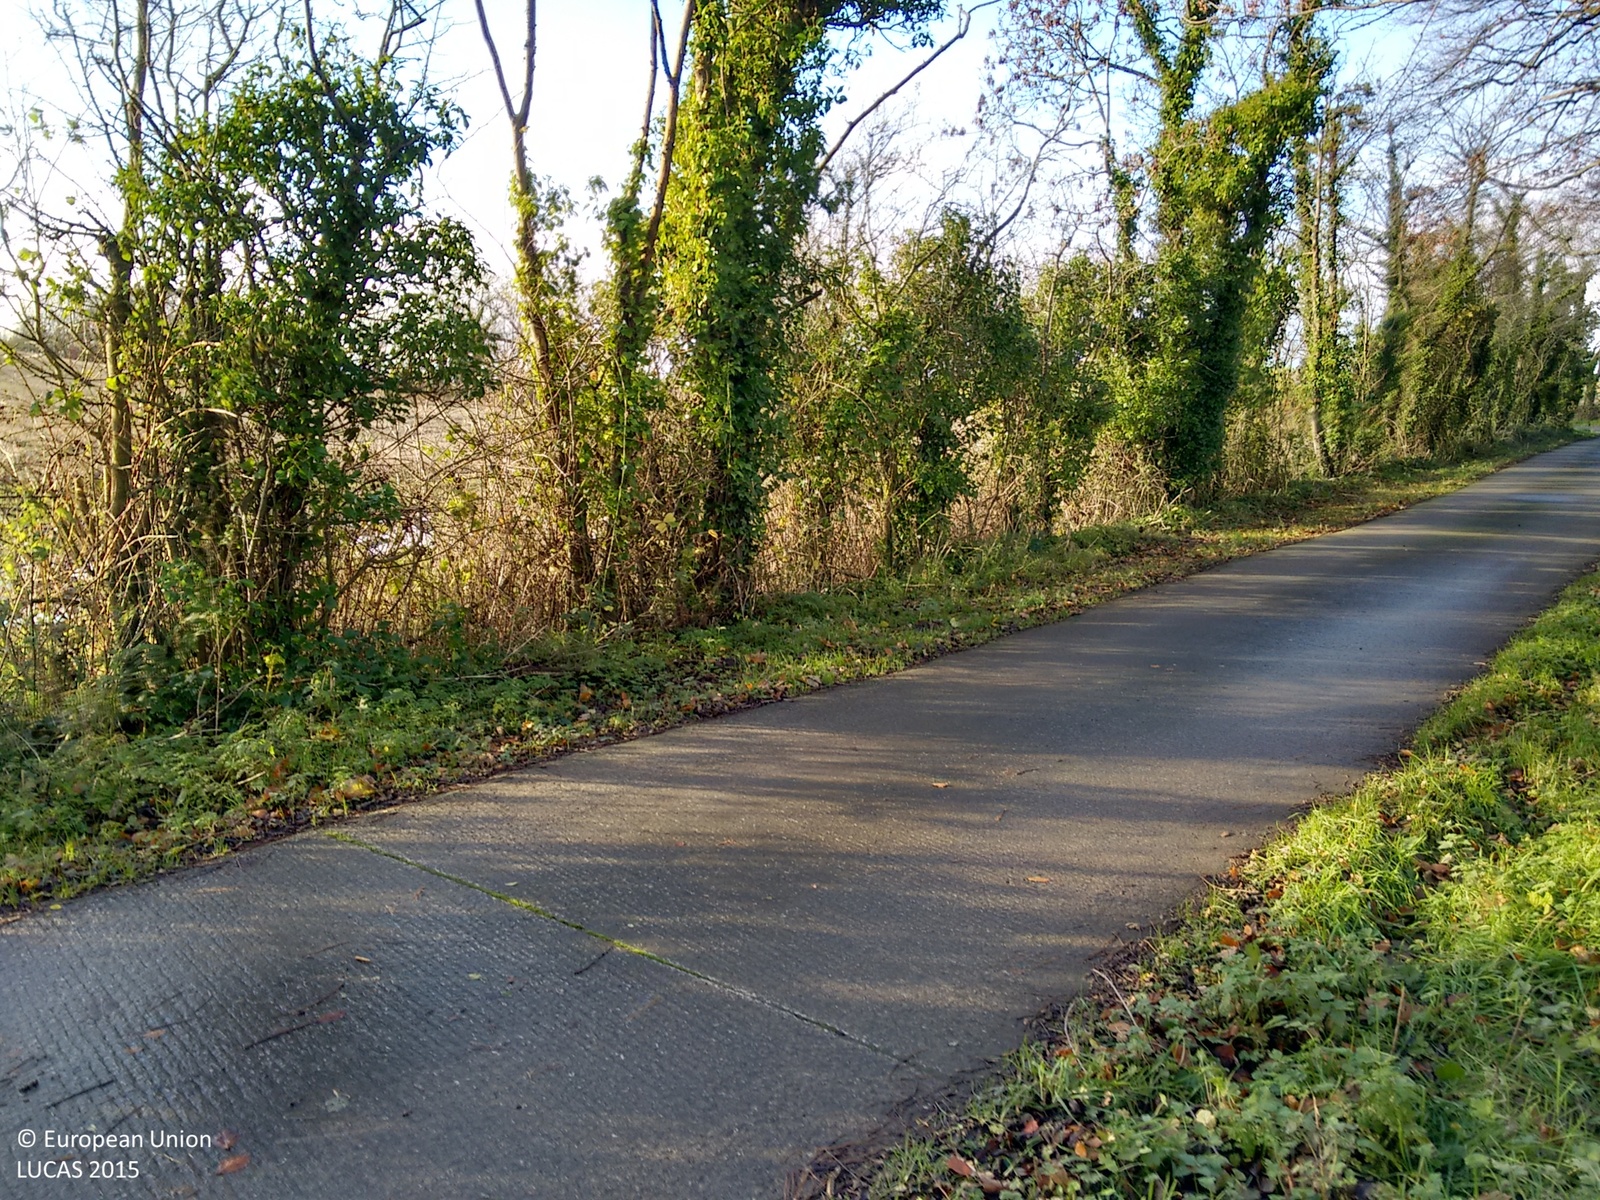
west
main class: Woodland
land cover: Broadleaved woodland
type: exotic forest
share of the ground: > 75 %
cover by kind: broadleaved forest trees 90 %, shrubs 5 %, herbaceous plants 5 %
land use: Semi-natural and natural areas not in use
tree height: > 5 m
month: November
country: GB
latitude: 54.4657
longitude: -5.5099
